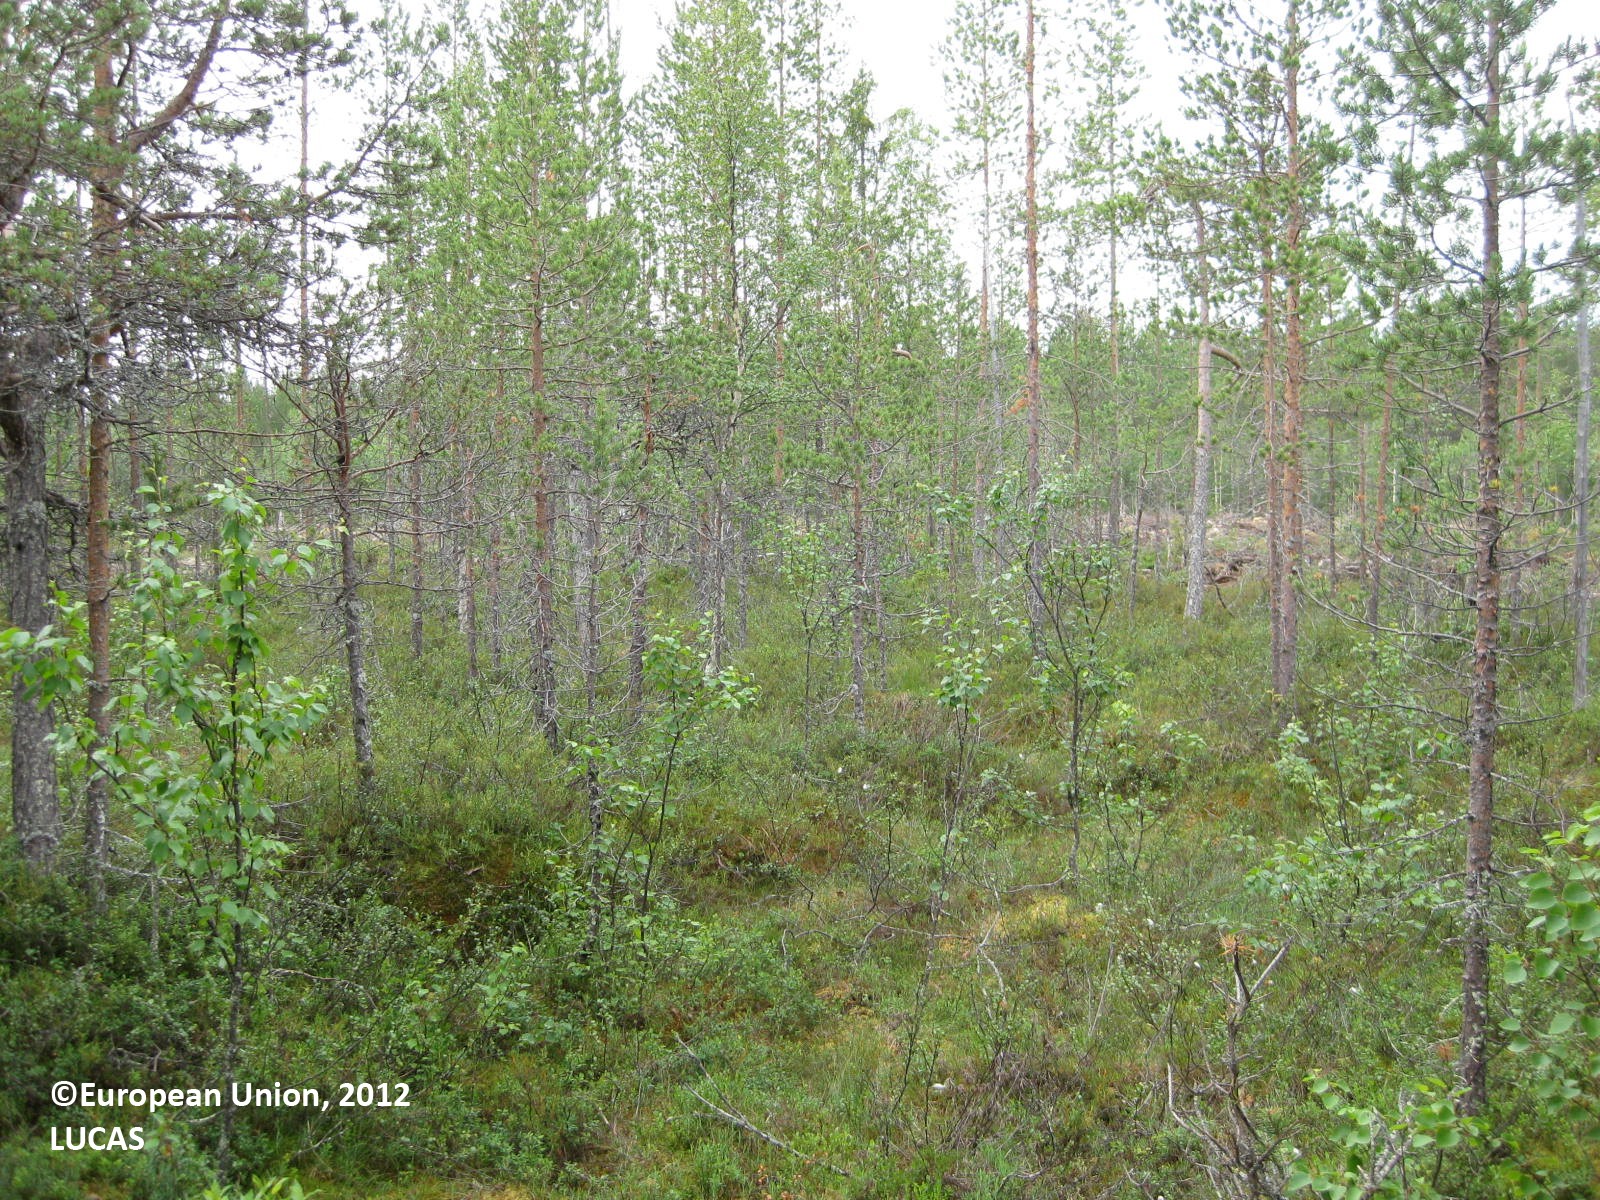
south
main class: Woodland
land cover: Pine dominated mixed woodland
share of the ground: > 75 %
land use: Forestry
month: July
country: FI
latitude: 65.7418
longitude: 29.3176
